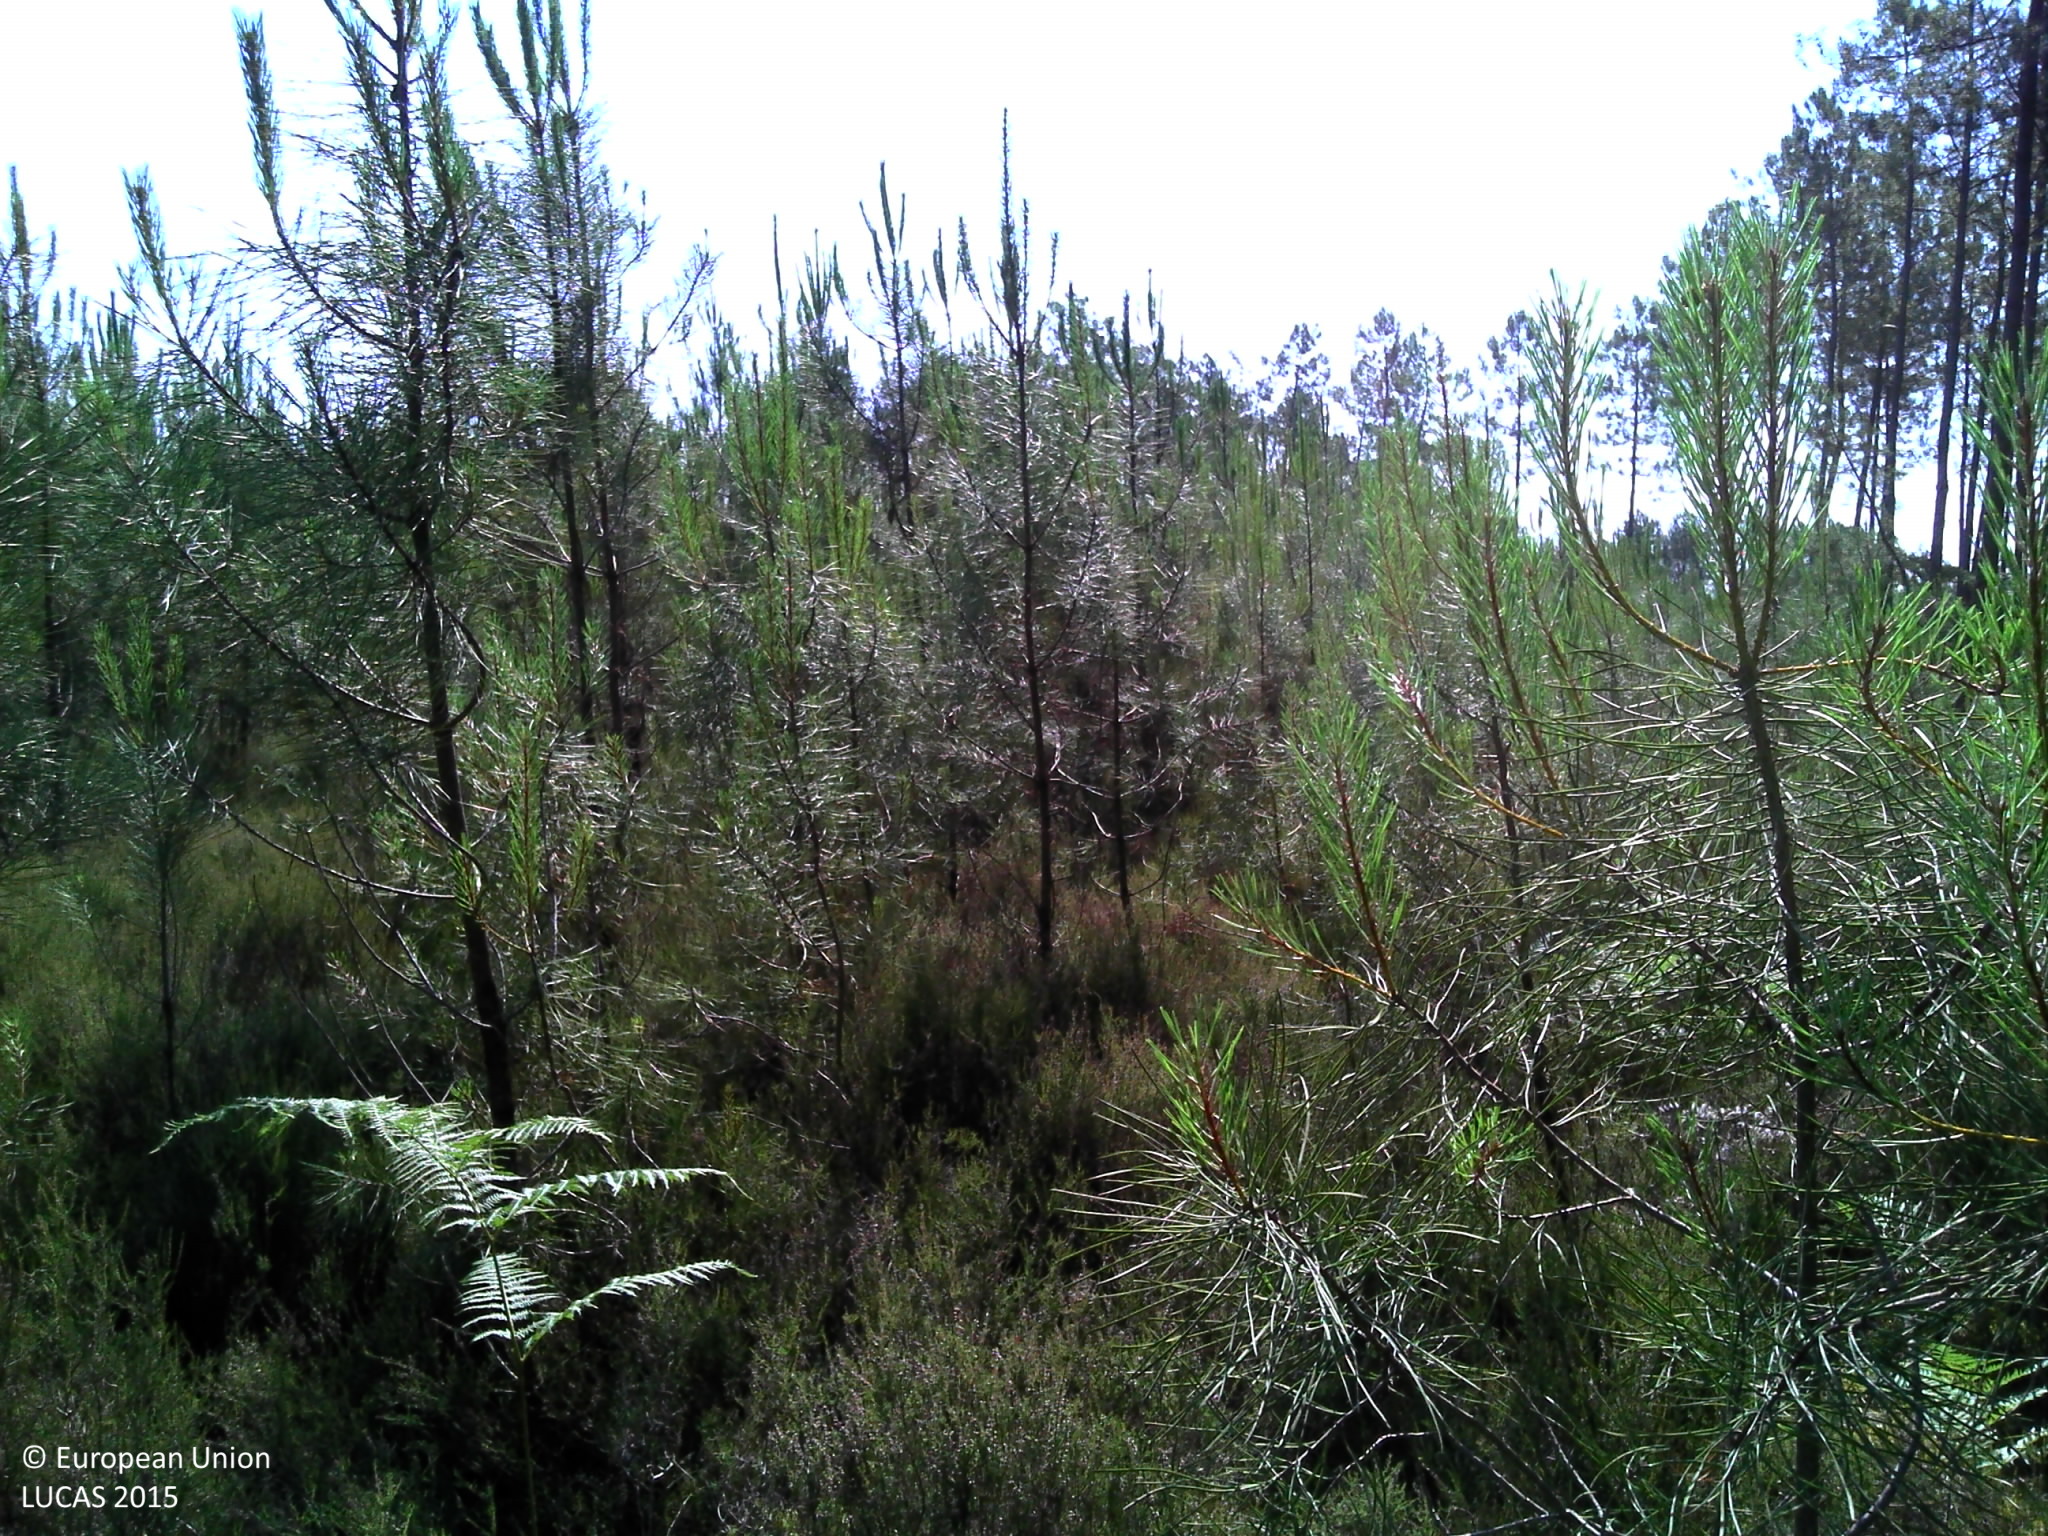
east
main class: Woodland
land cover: Pine dominated coniferous woodland
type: coniferous forest of the mediterranean region
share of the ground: > 75 %
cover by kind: coniferous forest trees 80 %, shrubs 15 %, herbaceous plants 5 %
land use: Forestry
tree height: > 5 m
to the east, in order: Pine dominated coniferous woodland; Shrubland without tree cover; Pine dominated coniferous woodland; Tracks; Grass margins; Shrubland without tree cover; Spontaneously vegetated surfaces; Fences; Paved roads, cycling and walking lanes; Spontaneously vegetated surfaces; Fences; Spontaneously vegetated surfaces; Fences; Paved roads, cycling and walking lanes
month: June
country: FR
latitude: 44.0920
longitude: -0.2908
